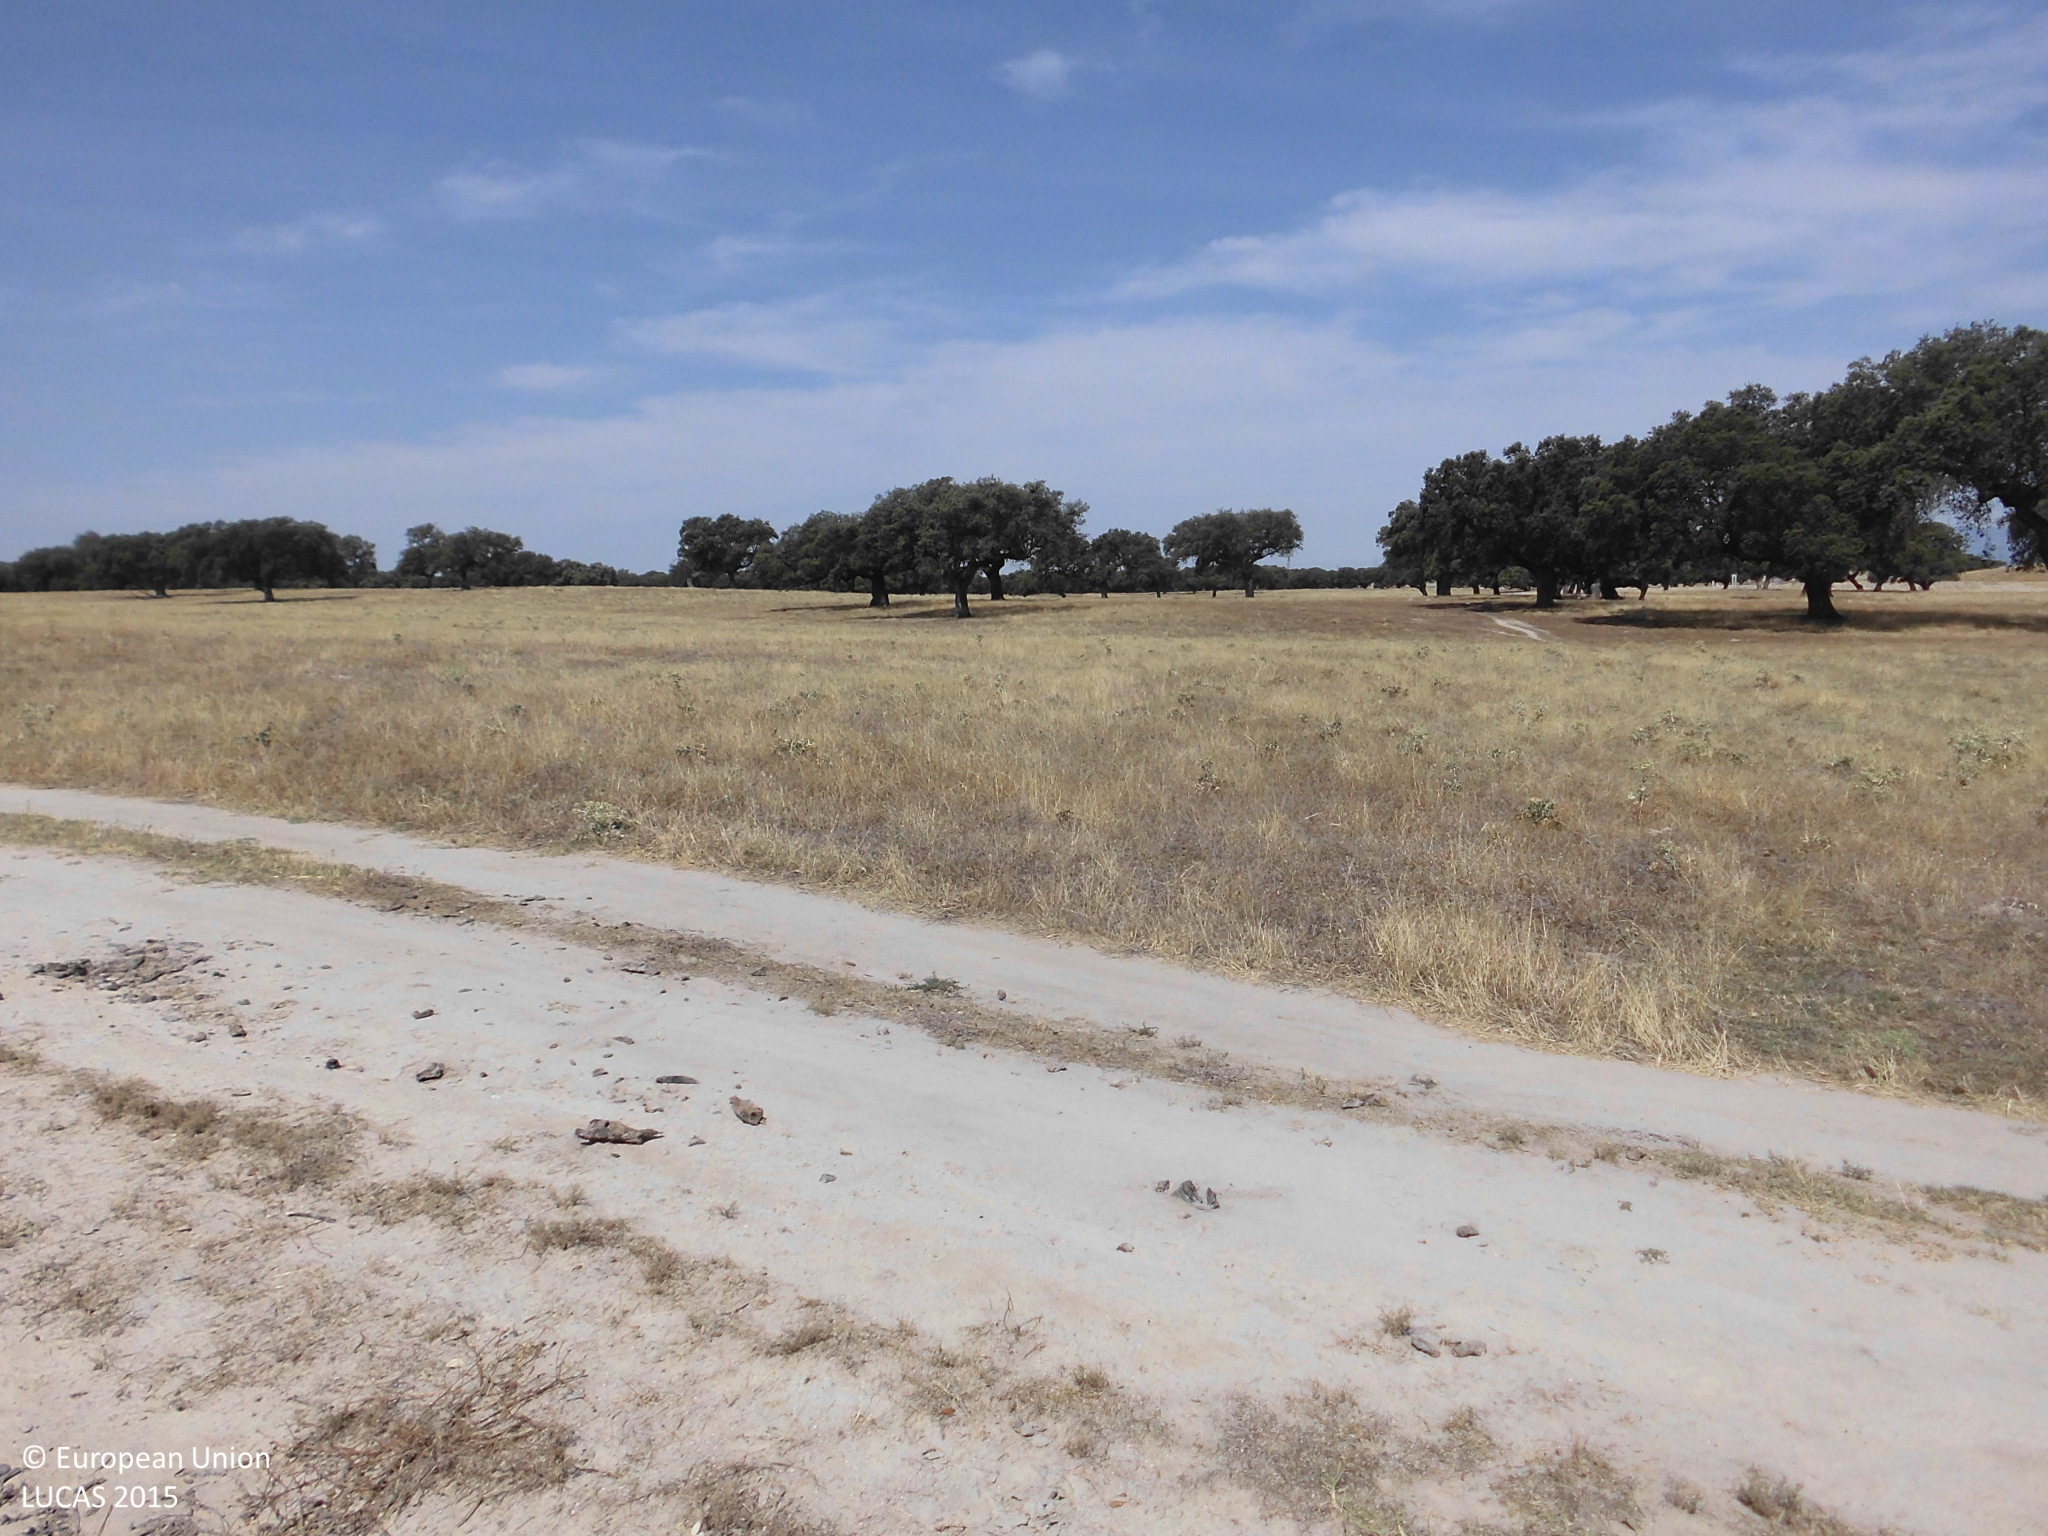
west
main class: Woodland
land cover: Broadleaved woodland
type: broadleaved evergreen forest
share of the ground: 10 - 25 %
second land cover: Grassland without tree/shrub cover
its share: > 75 %
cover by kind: herbaceous plants 85 %, broadleaved forest trees 10 %, unconsolidated bare surface 5 %
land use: Forestry
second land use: Agriculture (excluding fallow land and kitchen gardens)
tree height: > 5 m
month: July
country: ES
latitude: 39.9047
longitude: -5.4150
